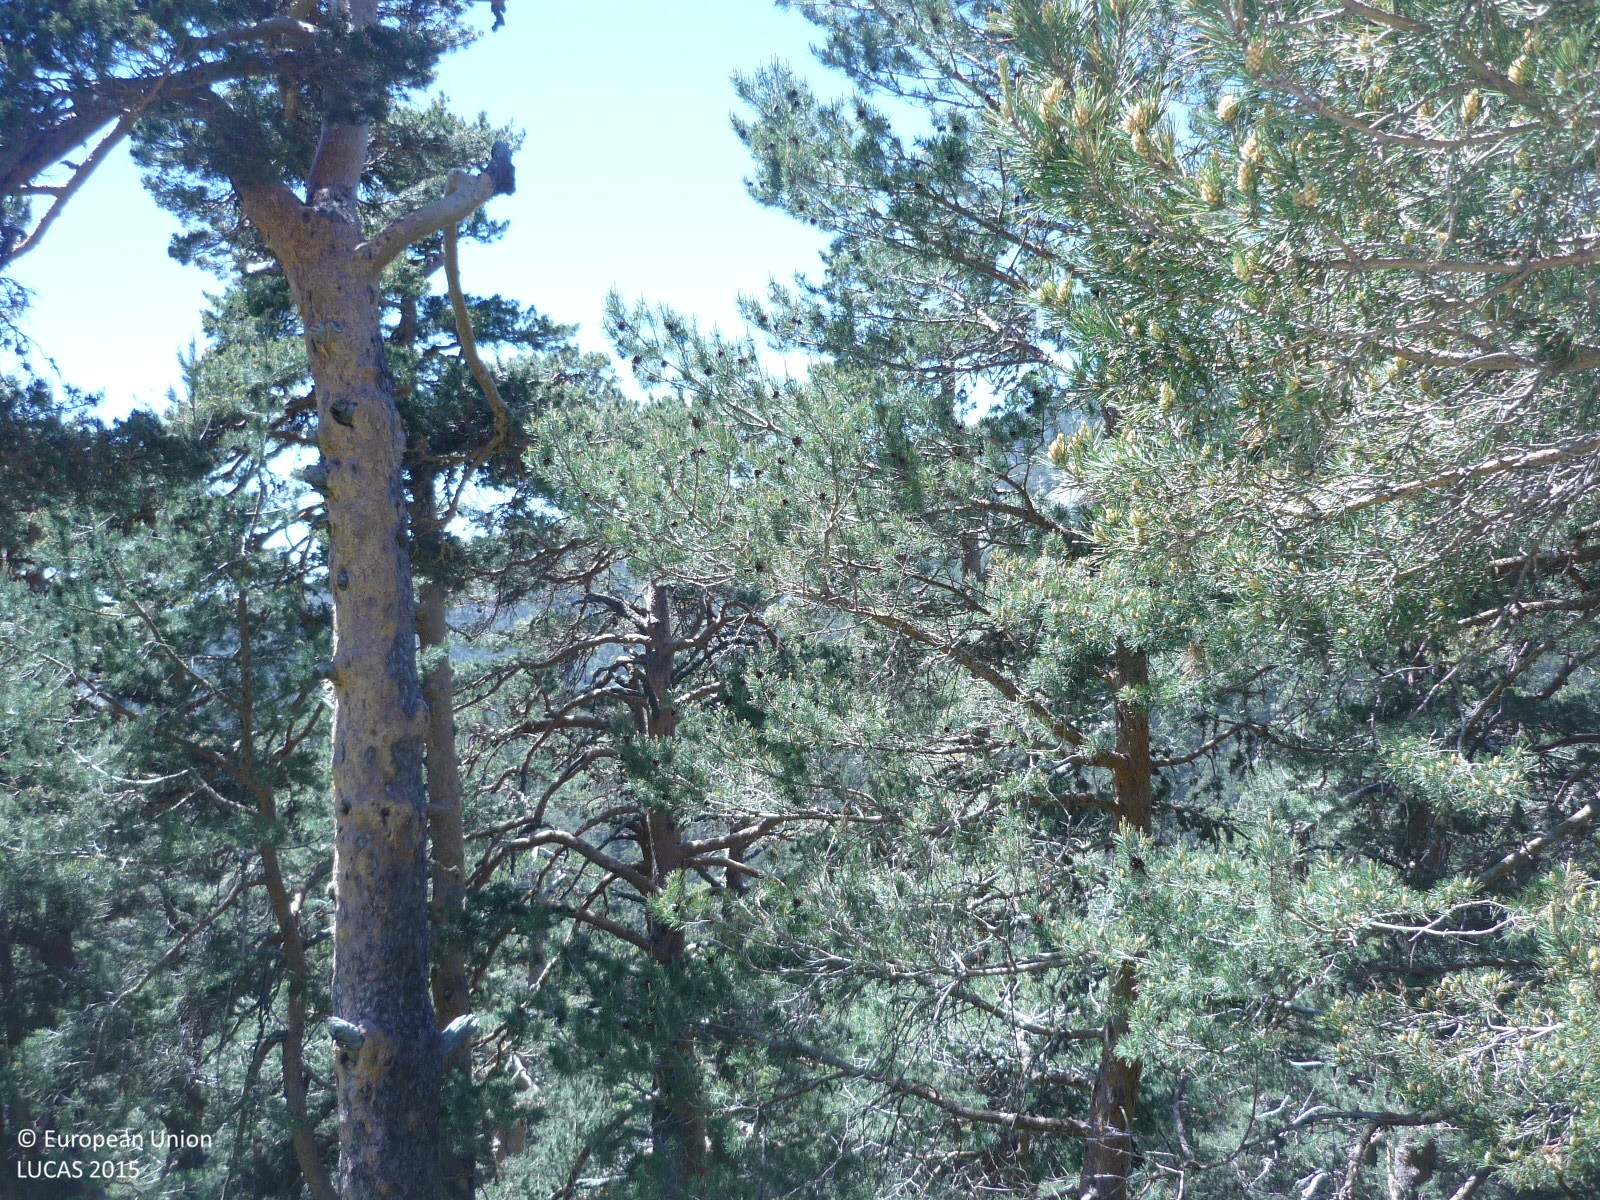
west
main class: Woodland
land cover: Pine dominated coniferous woodland
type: coniferous forest of the mediterranean region
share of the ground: > 75 %
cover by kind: coniferous forest trees 85 %, shrubs 10 %, herbaceous plants 5 %
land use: Forestry
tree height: > 5 m
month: May
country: ES
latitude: 40.7768
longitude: -4.0161
